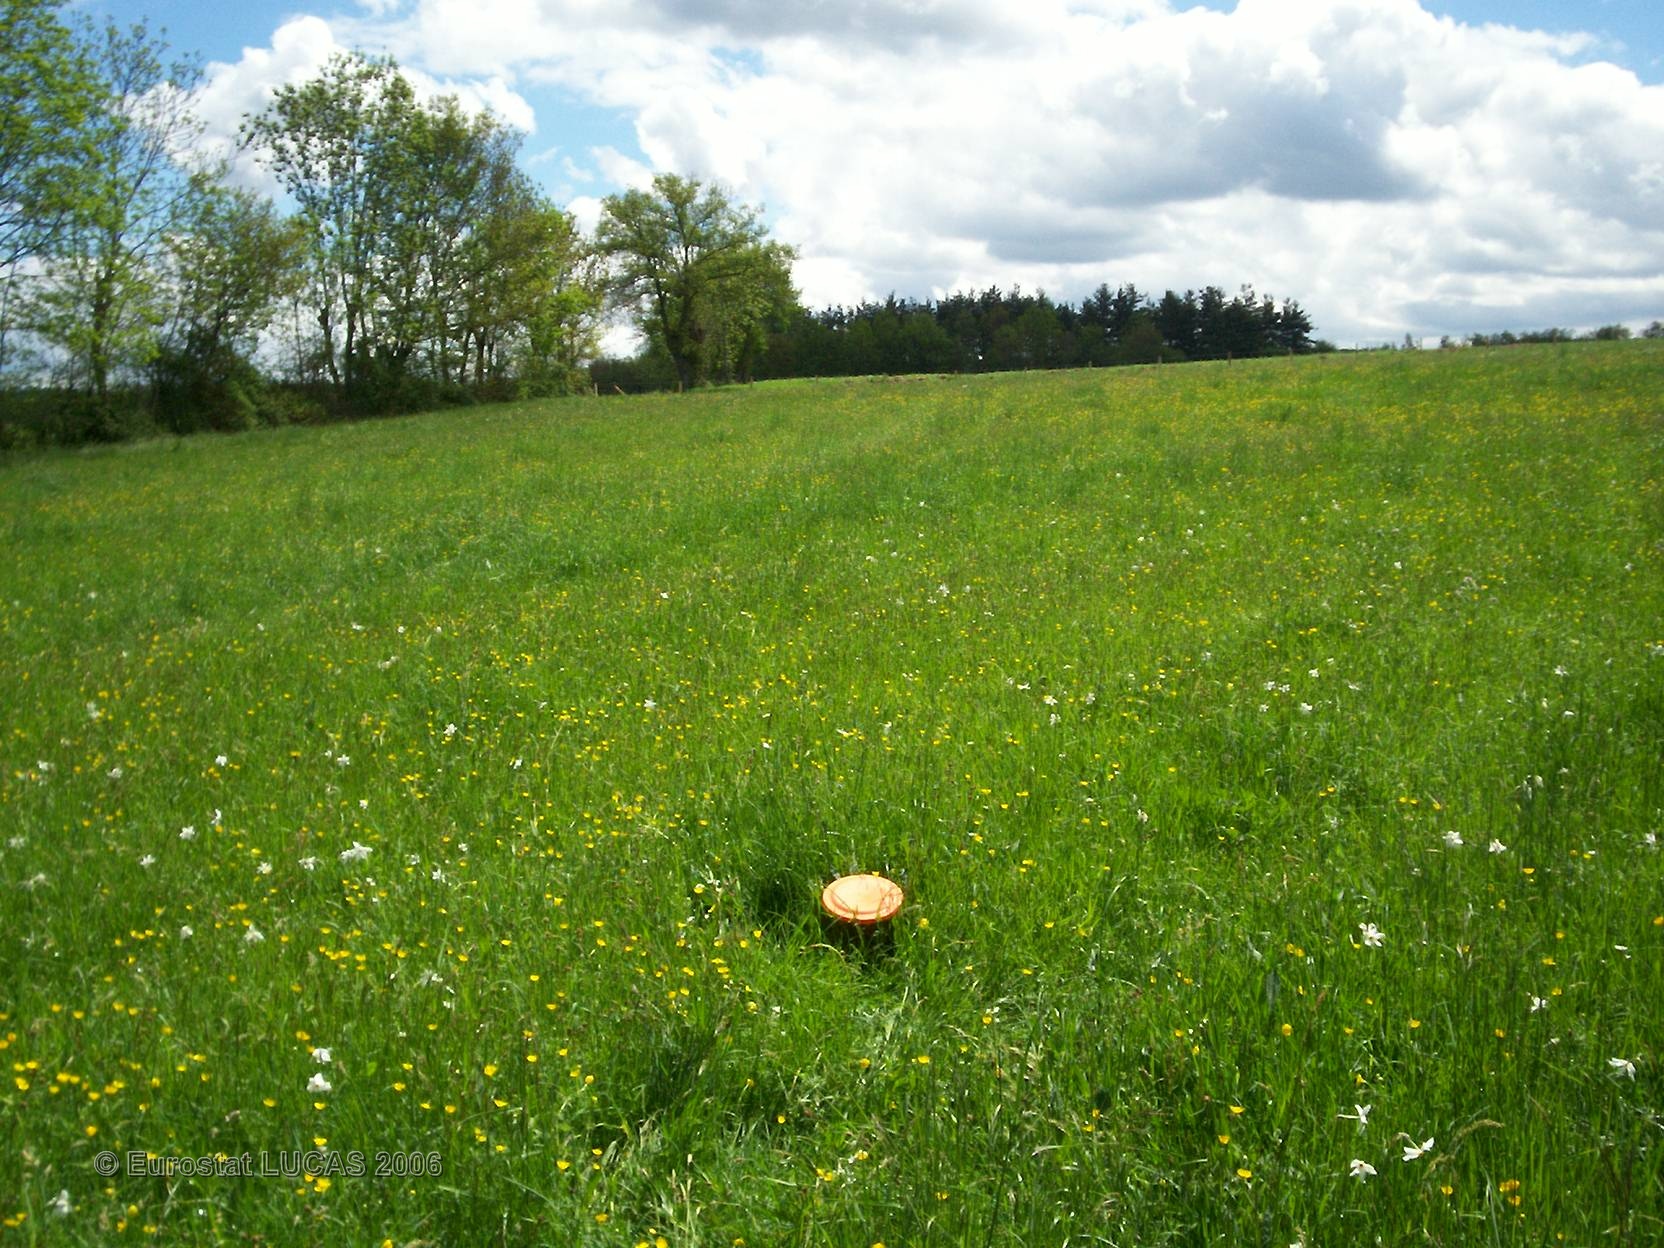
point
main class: Grassland
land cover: Grassland without tree/shrub cover
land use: Agriculture (excluding fallow land and kitchen gardens)
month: May
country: FR
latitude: 45.2561
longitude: 3.3122
